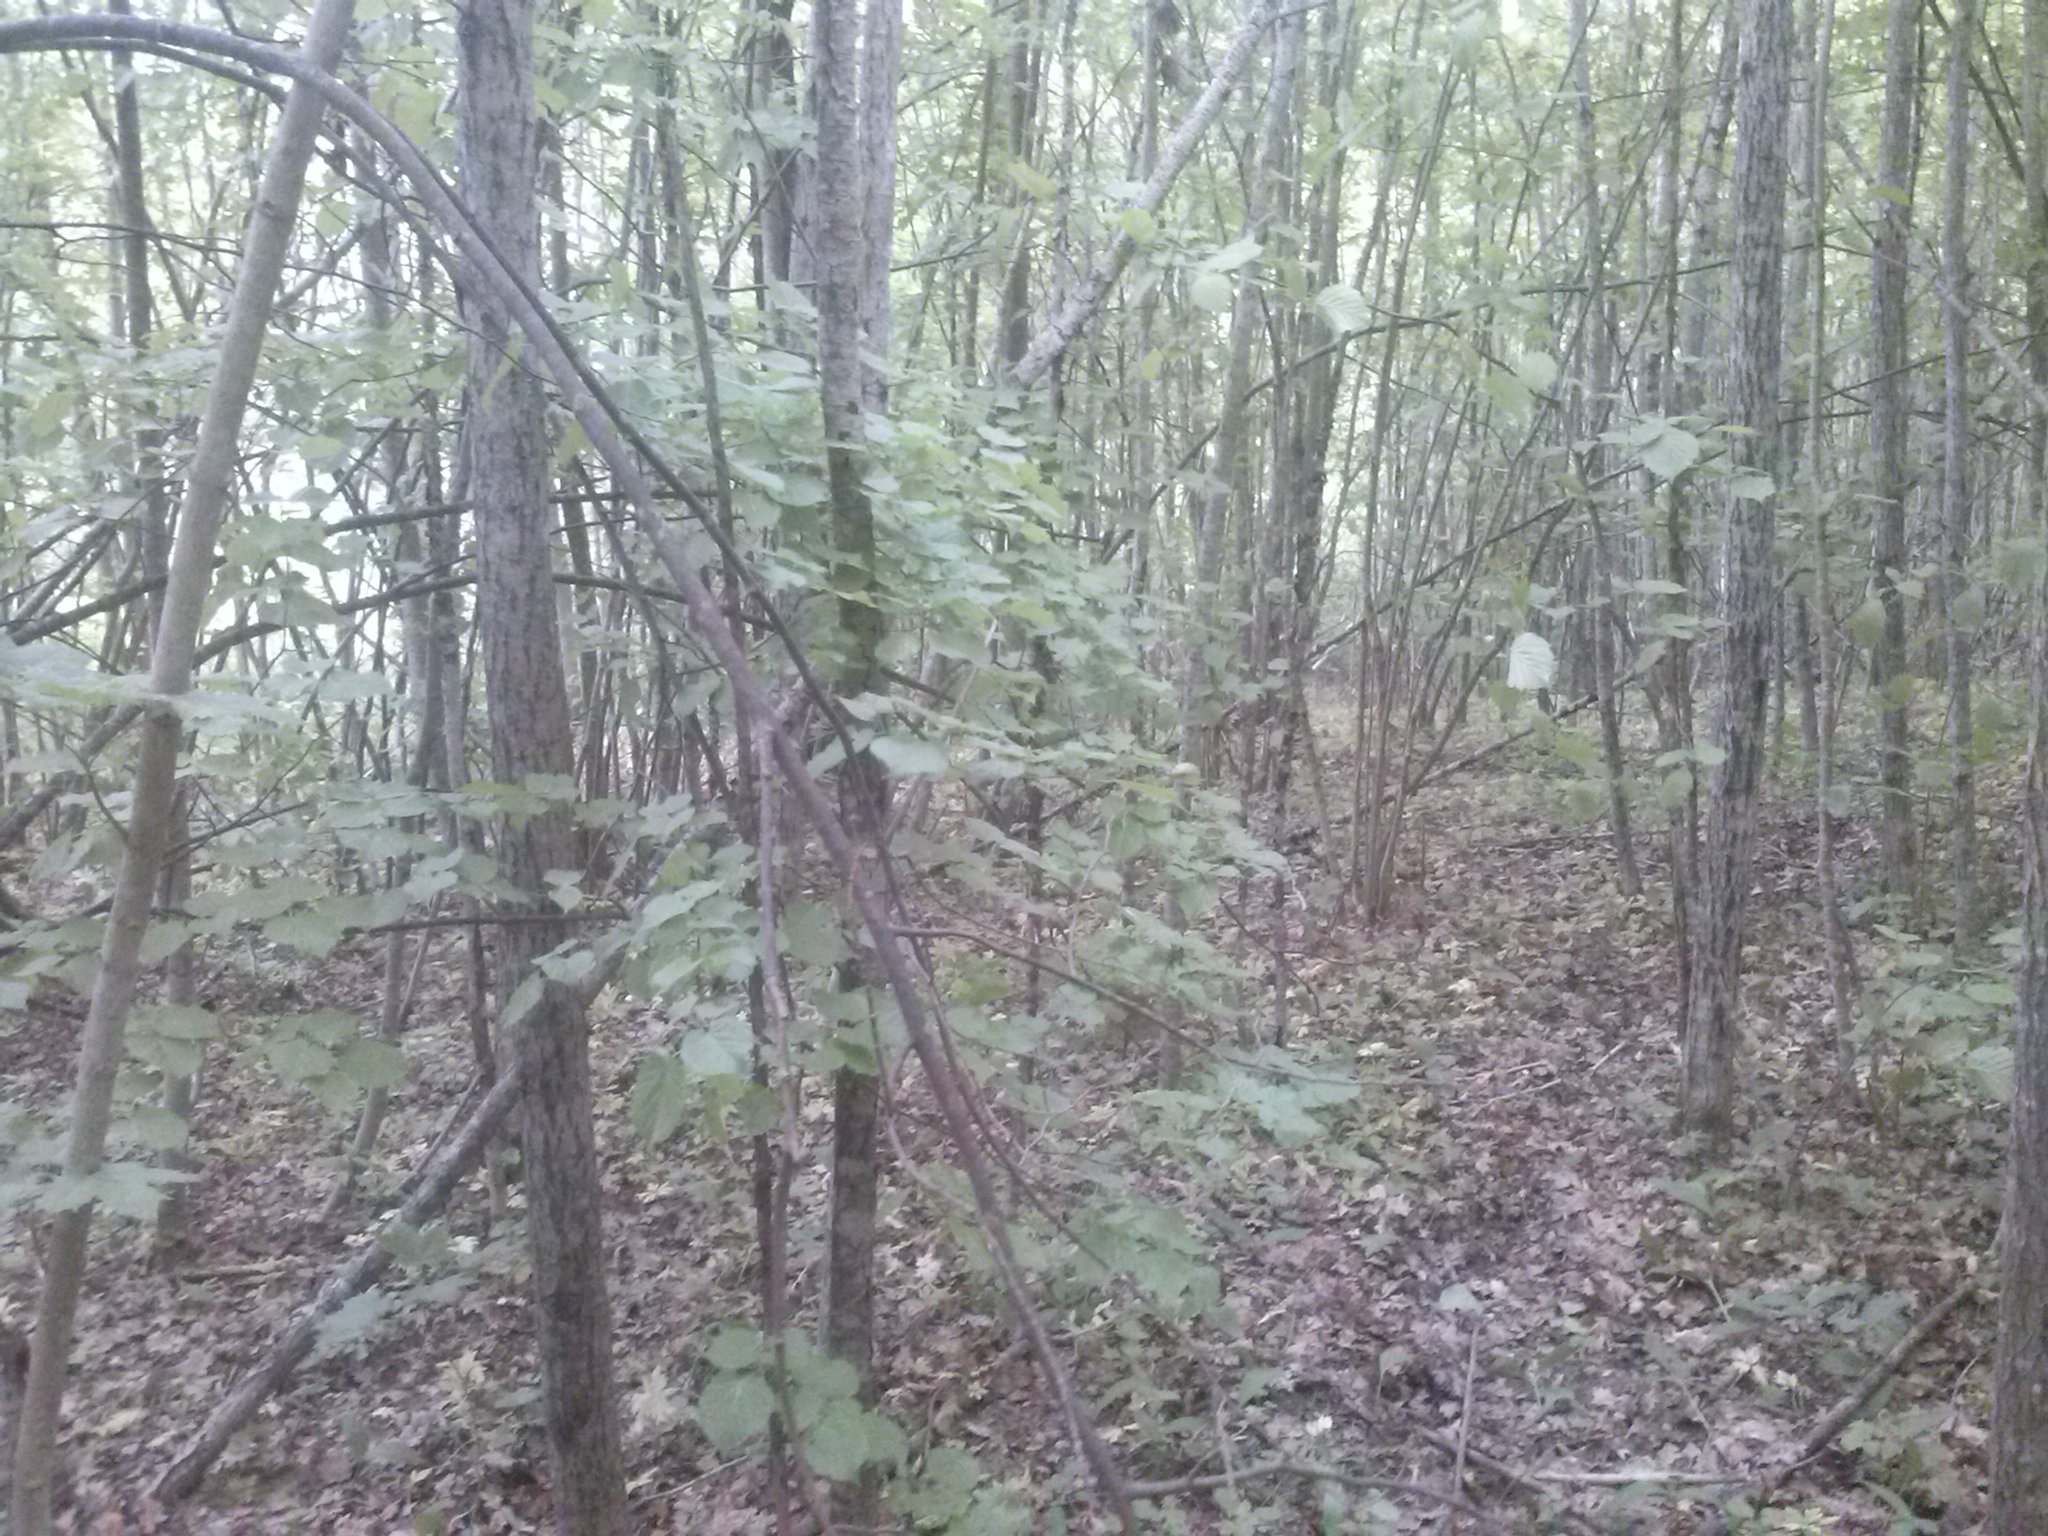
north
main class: Woodland
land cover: Broadleaved woodland
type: non-riverine alder, birch or aspen forest
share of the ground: > 75 %
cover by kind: broadleaved forest trees 80 %, shrubs 5 %, herbaceous plants 5 %, unconsolidated bare surface 5 %
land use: Forestry
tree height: > 5 m
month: June
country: LV
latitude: 56.2924
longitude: 27.5508
